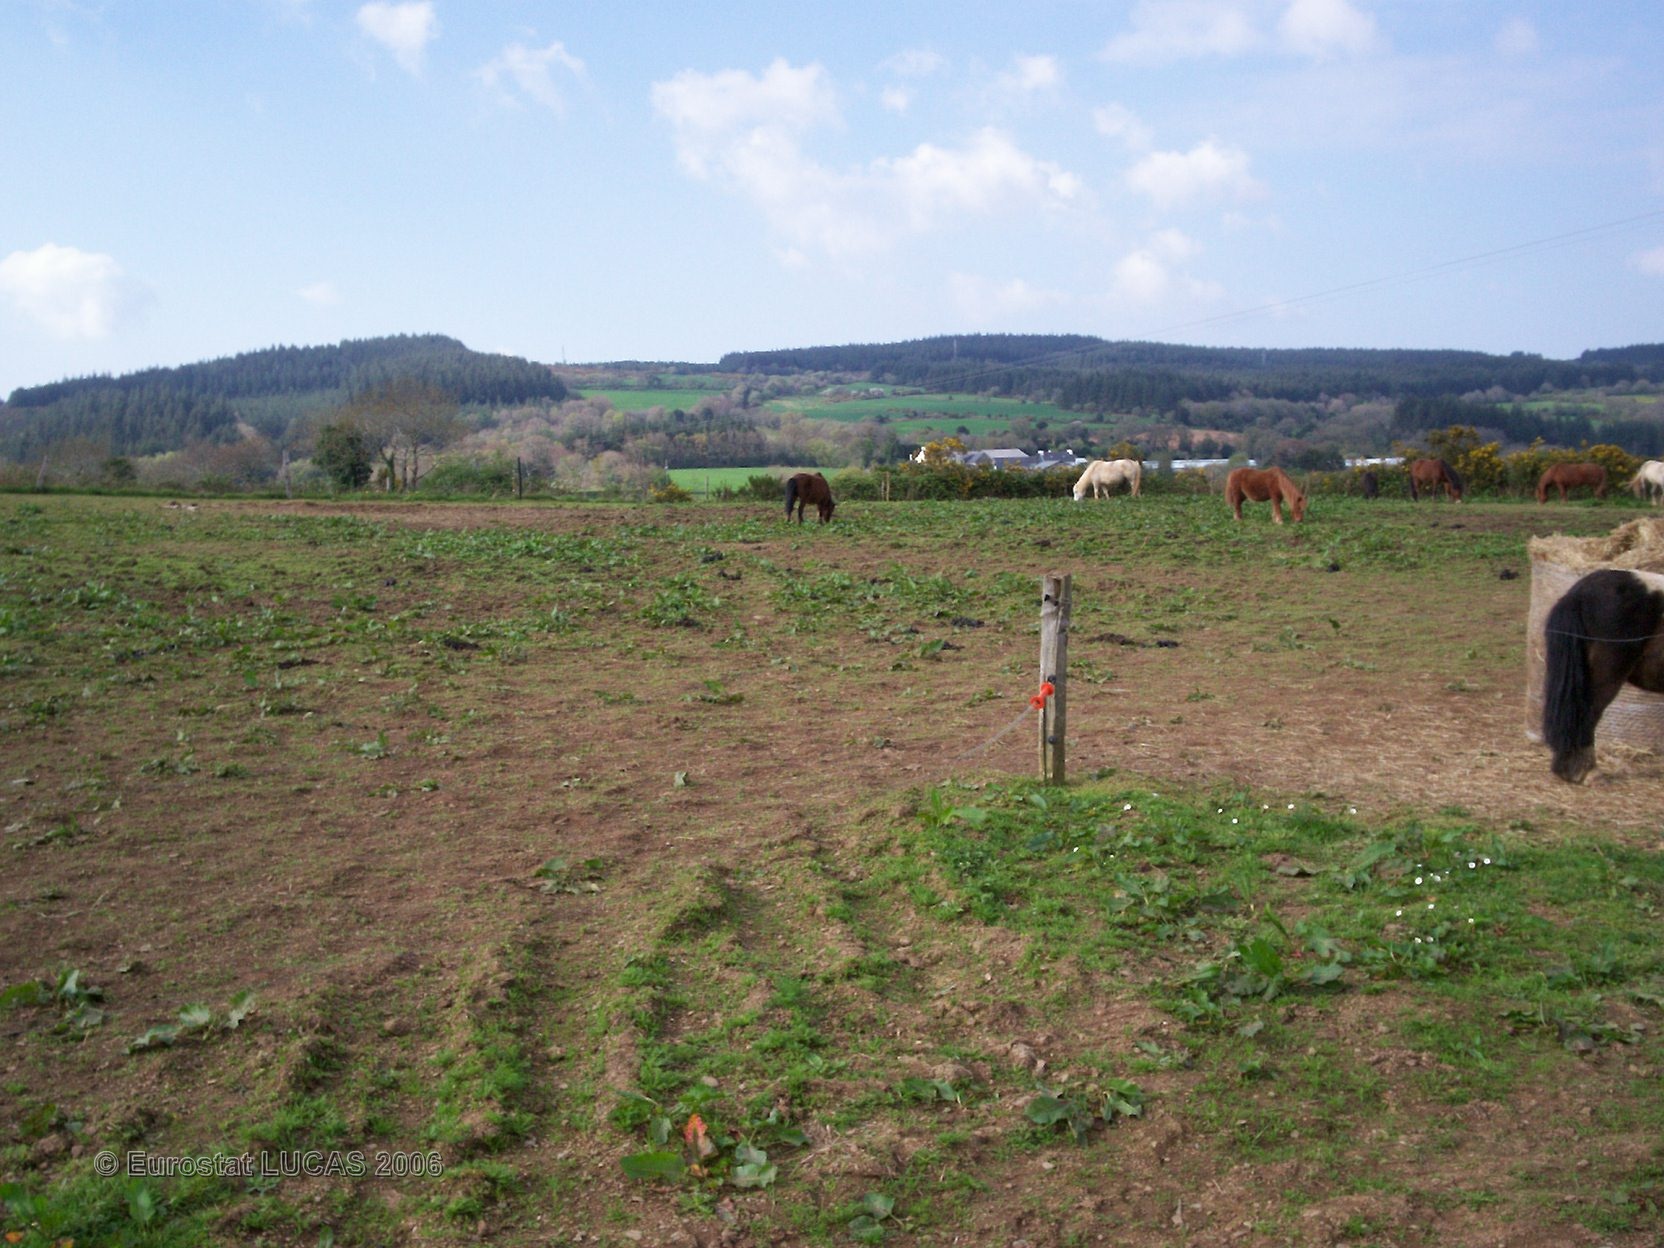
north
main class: Grassland
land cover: Grassland without tree/shrub cover
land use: Agriculture (excluding fallow land and kitchen gardens)
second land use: Amenities, museums, leisure
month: April
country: FR
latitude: 48.3154
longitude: -3.9630
